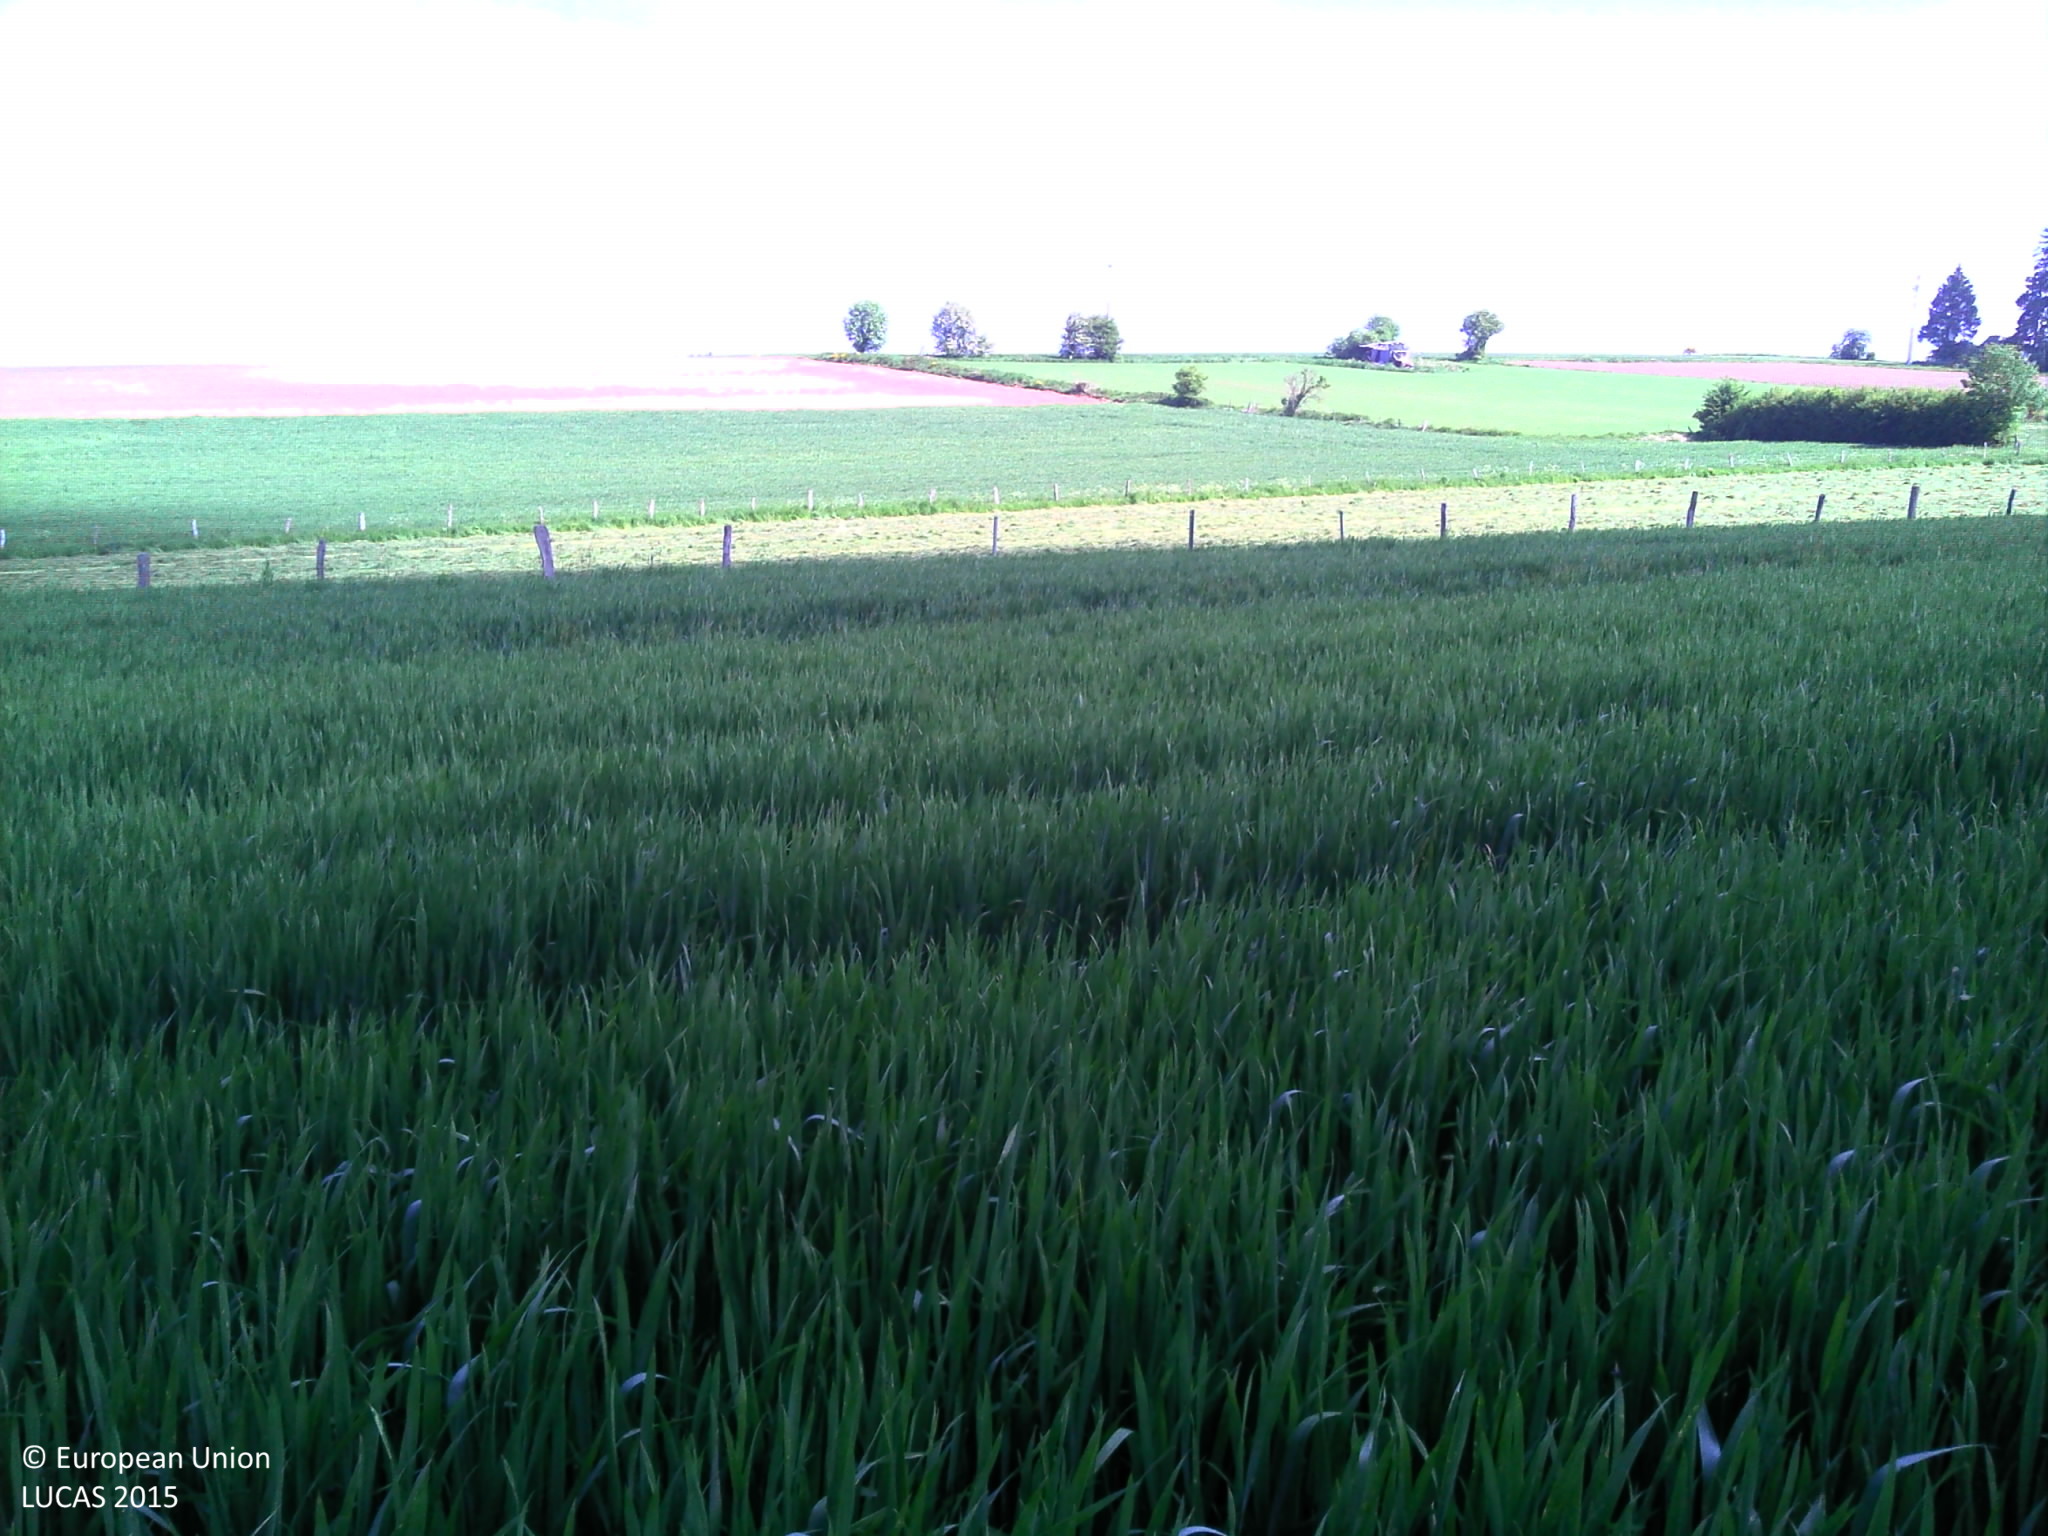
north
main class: Cropland
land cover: Common wheat
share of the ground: > 75 %
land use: Agriculture (excluding fallow land and kitchen gardens)
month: May
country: LU
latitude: 50.1325
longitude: 6.0120
